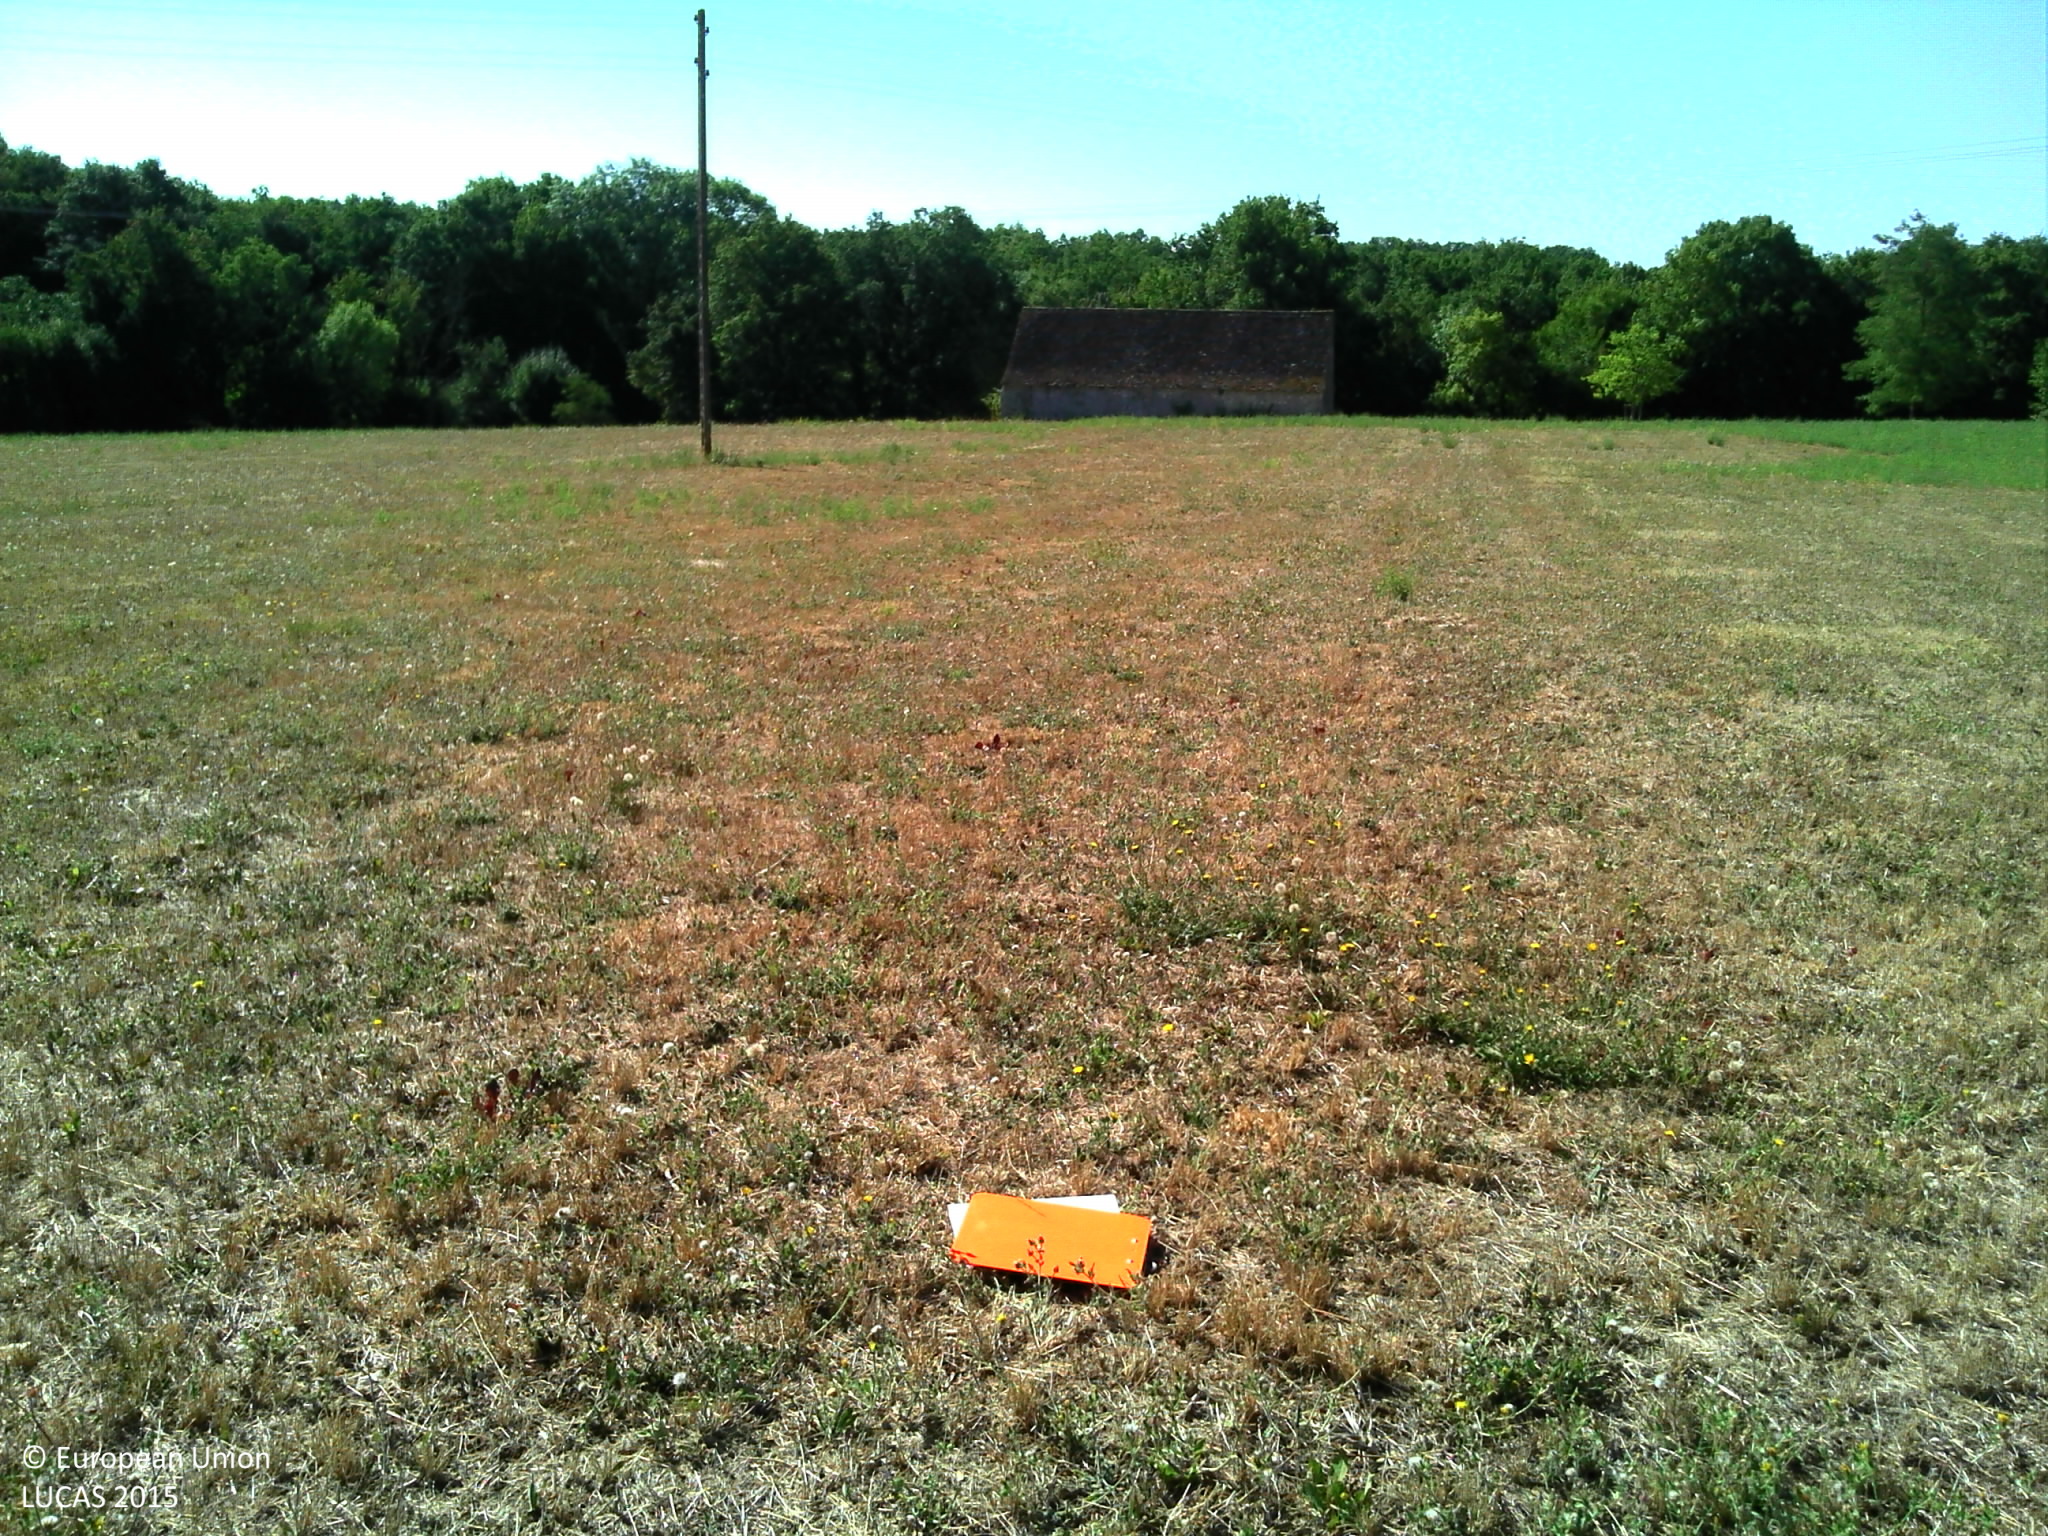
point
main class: Cropland
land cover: Temporary grasslands
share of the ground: > 75 %
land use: Agriculture (excluding fallow land and kitchen gardens)
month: August
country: FR
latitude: 44.7760
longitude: 0.6023
